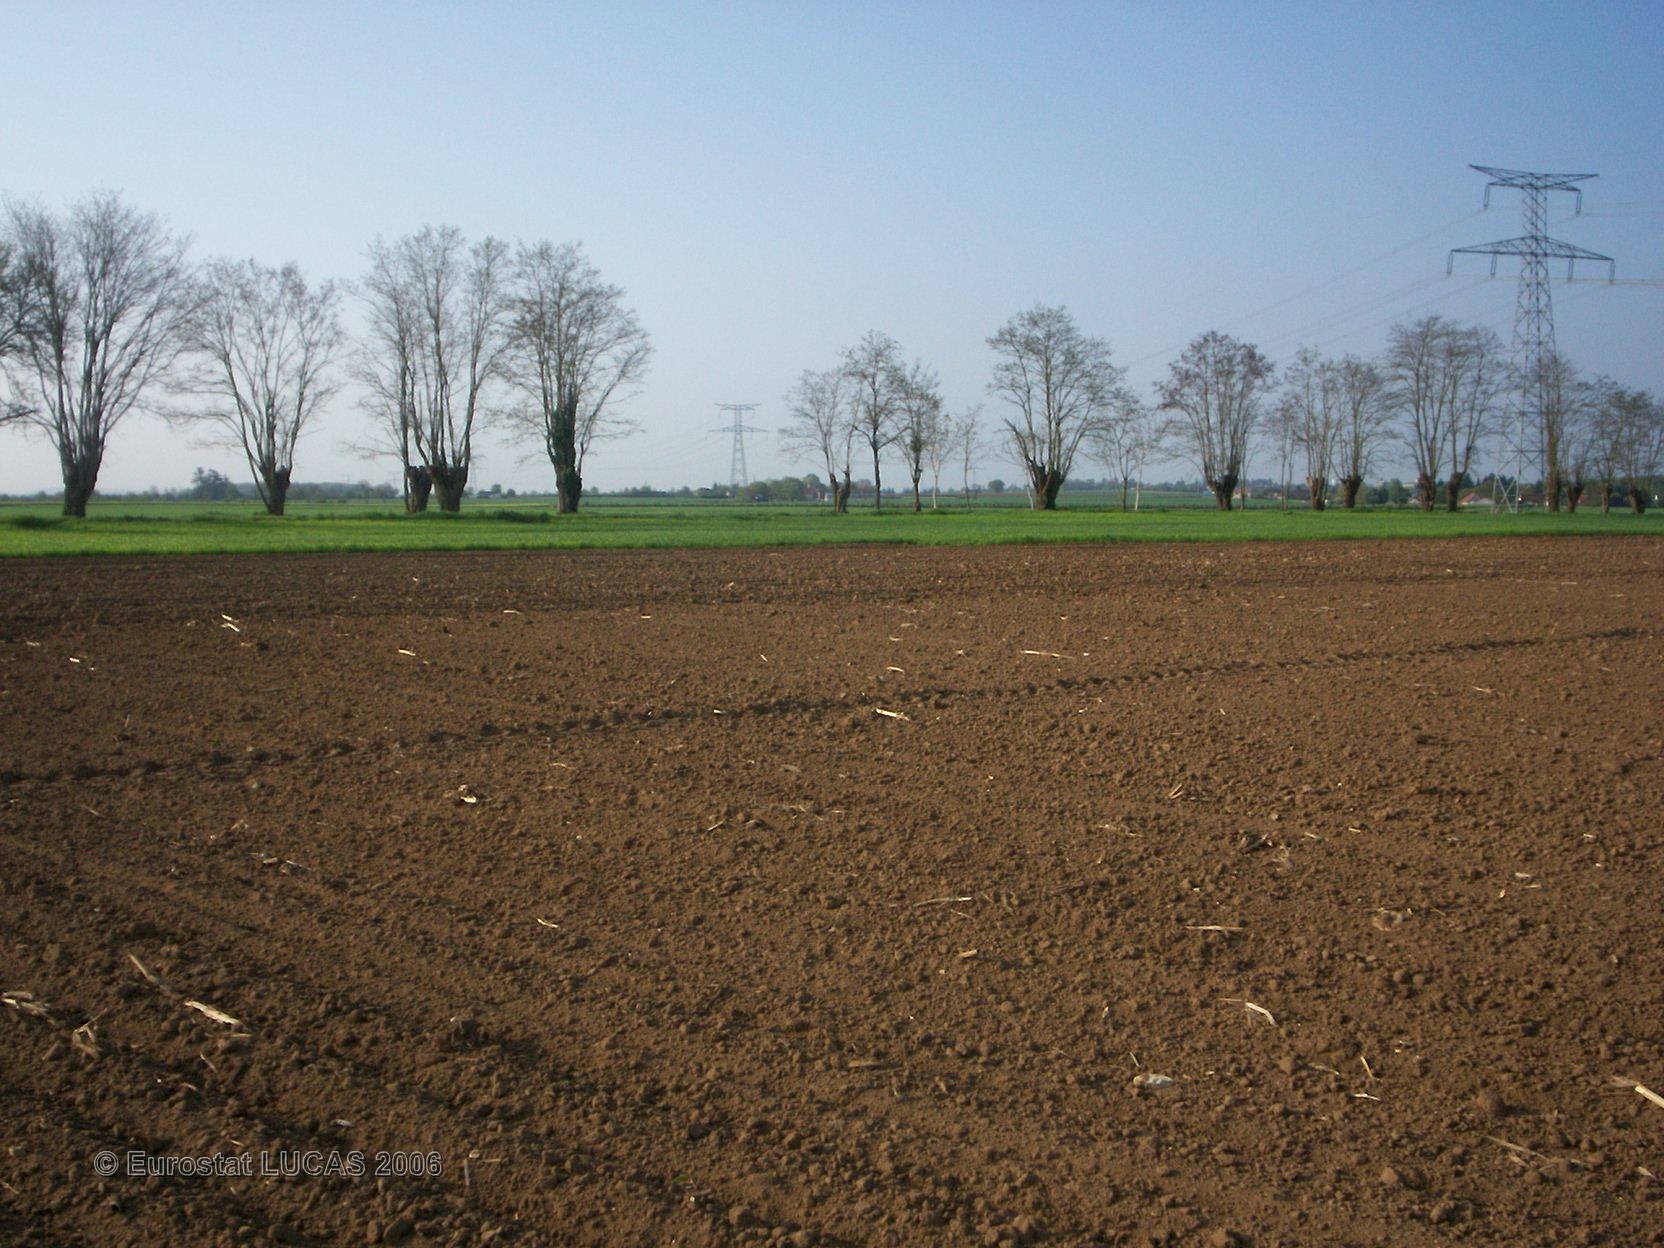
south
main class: Cropland
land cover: Maize
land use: Agriculture (excluding fallow land and kitchen gardens)
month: May
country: FR
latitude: 47.2085
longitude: 3.0375
